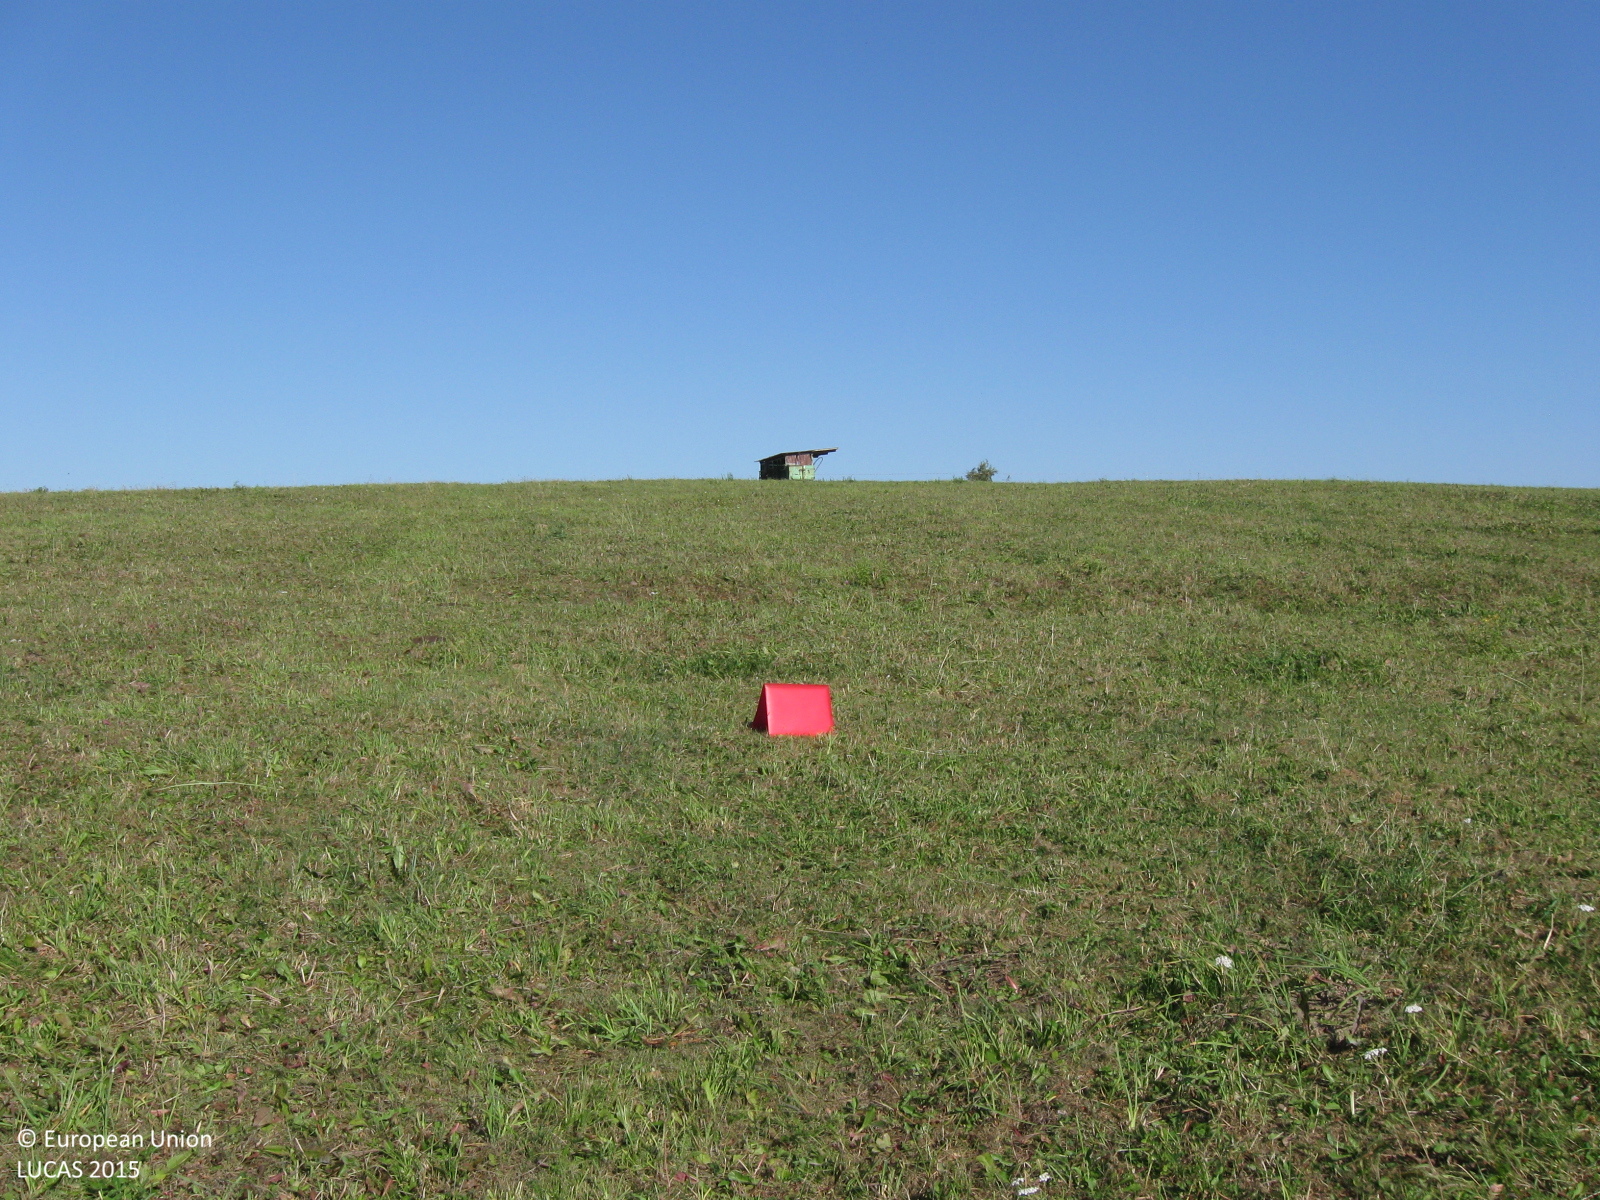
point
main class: Grassland
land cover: Grassland without tree/shrub cover
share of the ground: > 75 %
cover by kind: herbaceous plants 100 %
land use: Agriculture (excluding fallow land and kitchen gardens)
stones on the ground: < 10 %
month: August
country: LT
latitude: 55.4250
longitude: 22.5284
